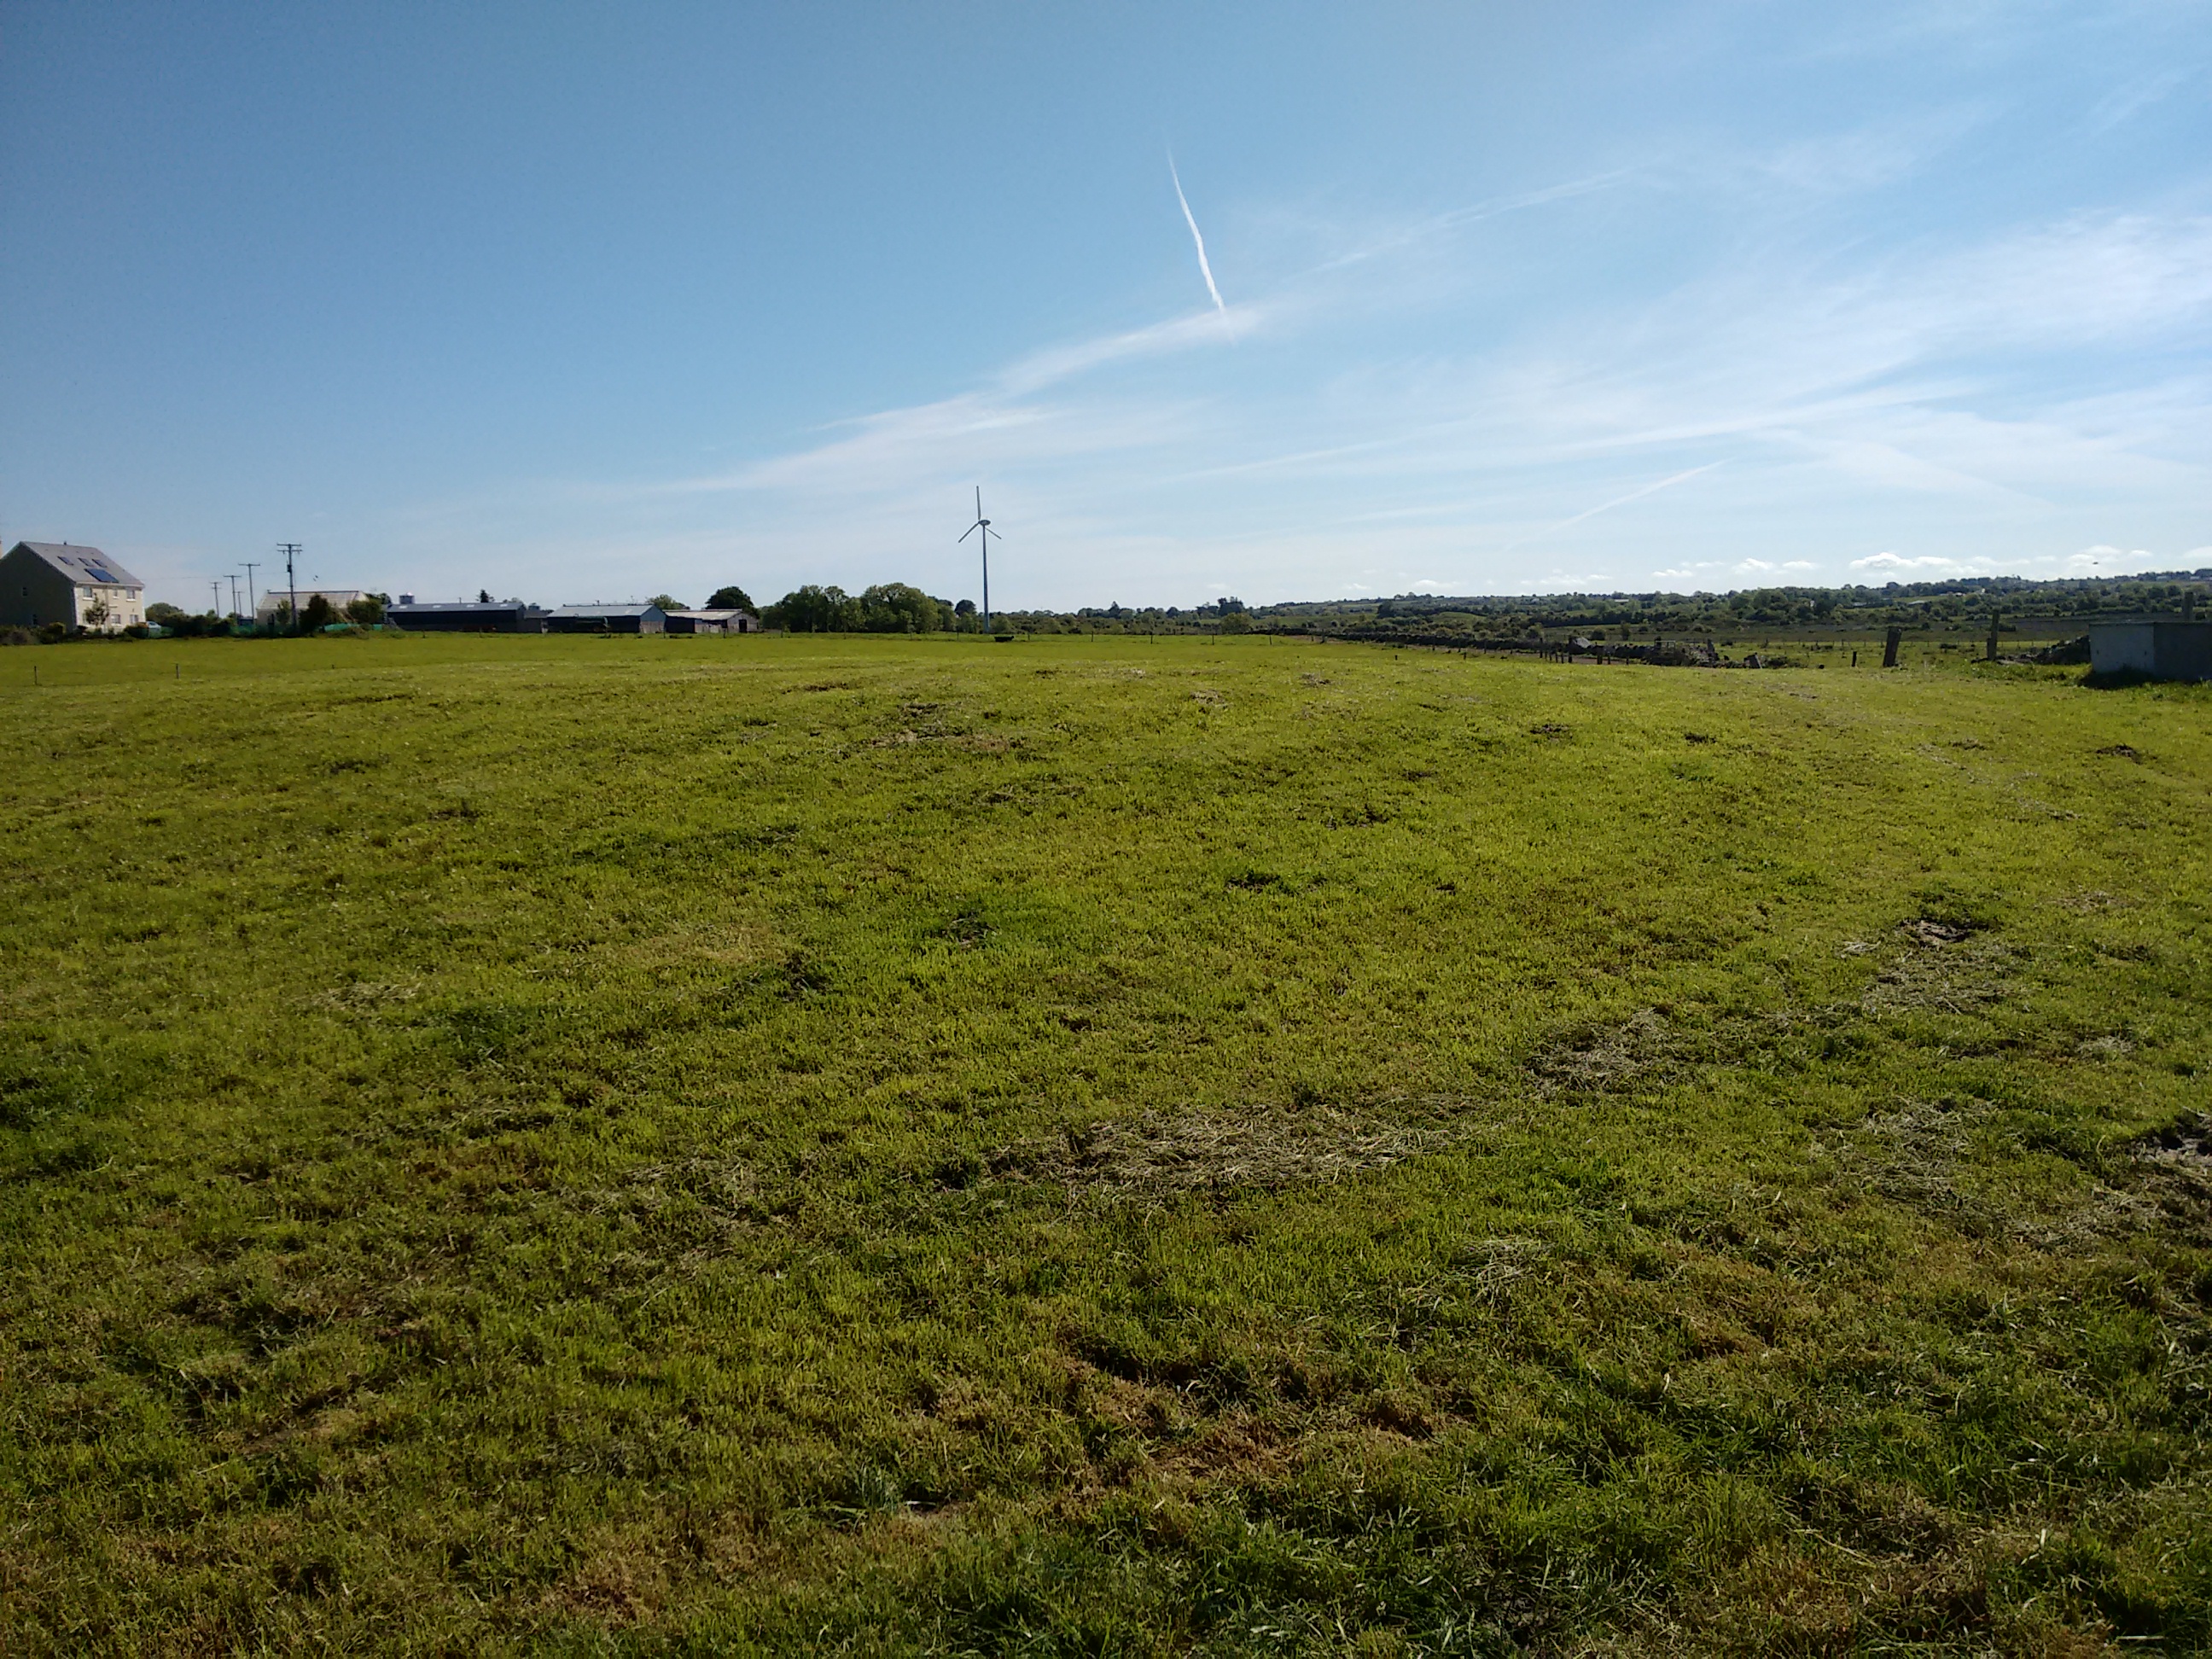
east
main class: Grassland
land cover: Grassland without tree/shrub cover
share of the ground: > 75 %
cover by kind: herbaceous plants 100 %
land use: Agriculture (excluding fallow land and kitchen gardens)
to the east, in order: Grassland without tree/shrub cover; Tracks; Electric lines; Tracks; Fences; Grassland without tree/shrub cover; Fences; Tracks; Fences; Grassland without tree/shrub cover
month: June
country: IE
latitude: 53.1902
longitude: -8.6530
